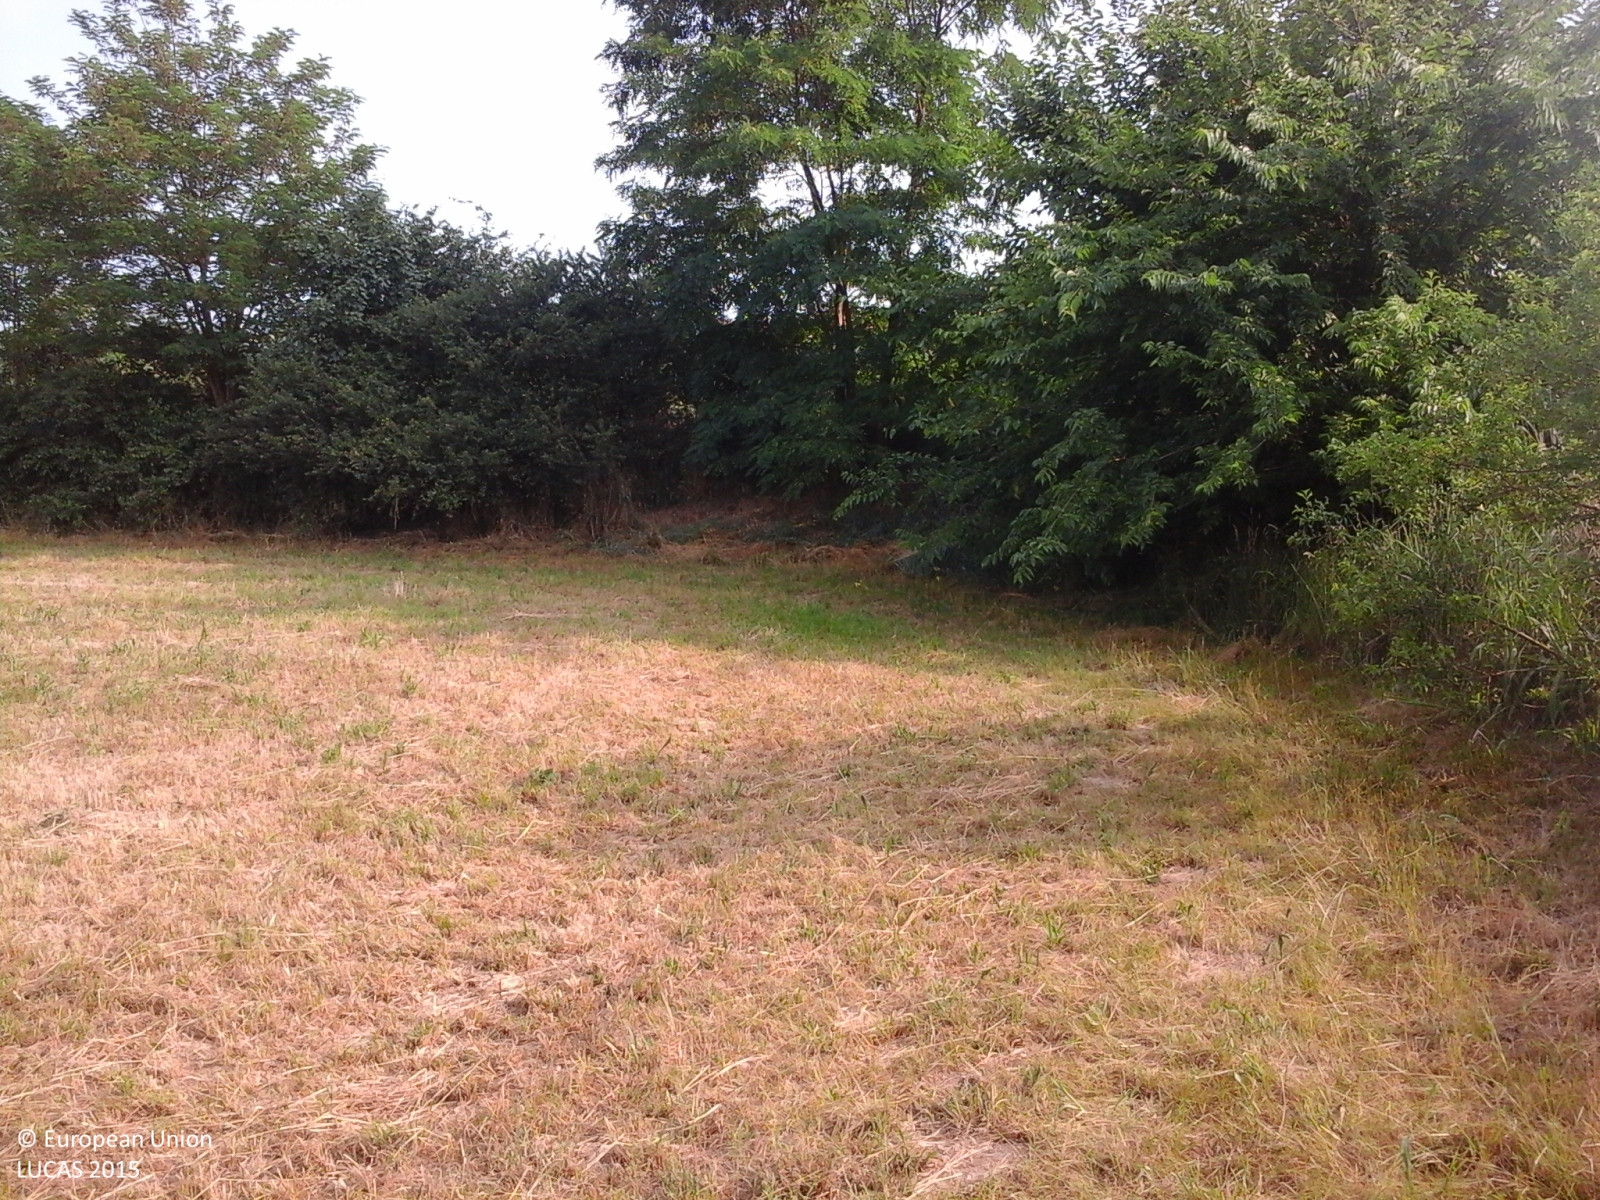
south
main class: Grassland
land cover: Spontaneously vegetated surfaces
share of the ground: > 75 %
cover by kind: herbaceous plants 100 %
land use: Agriculture (excluding fallow land and kitchen gardens)
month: June
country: IT
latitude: 45.4647
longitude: 10.8810
